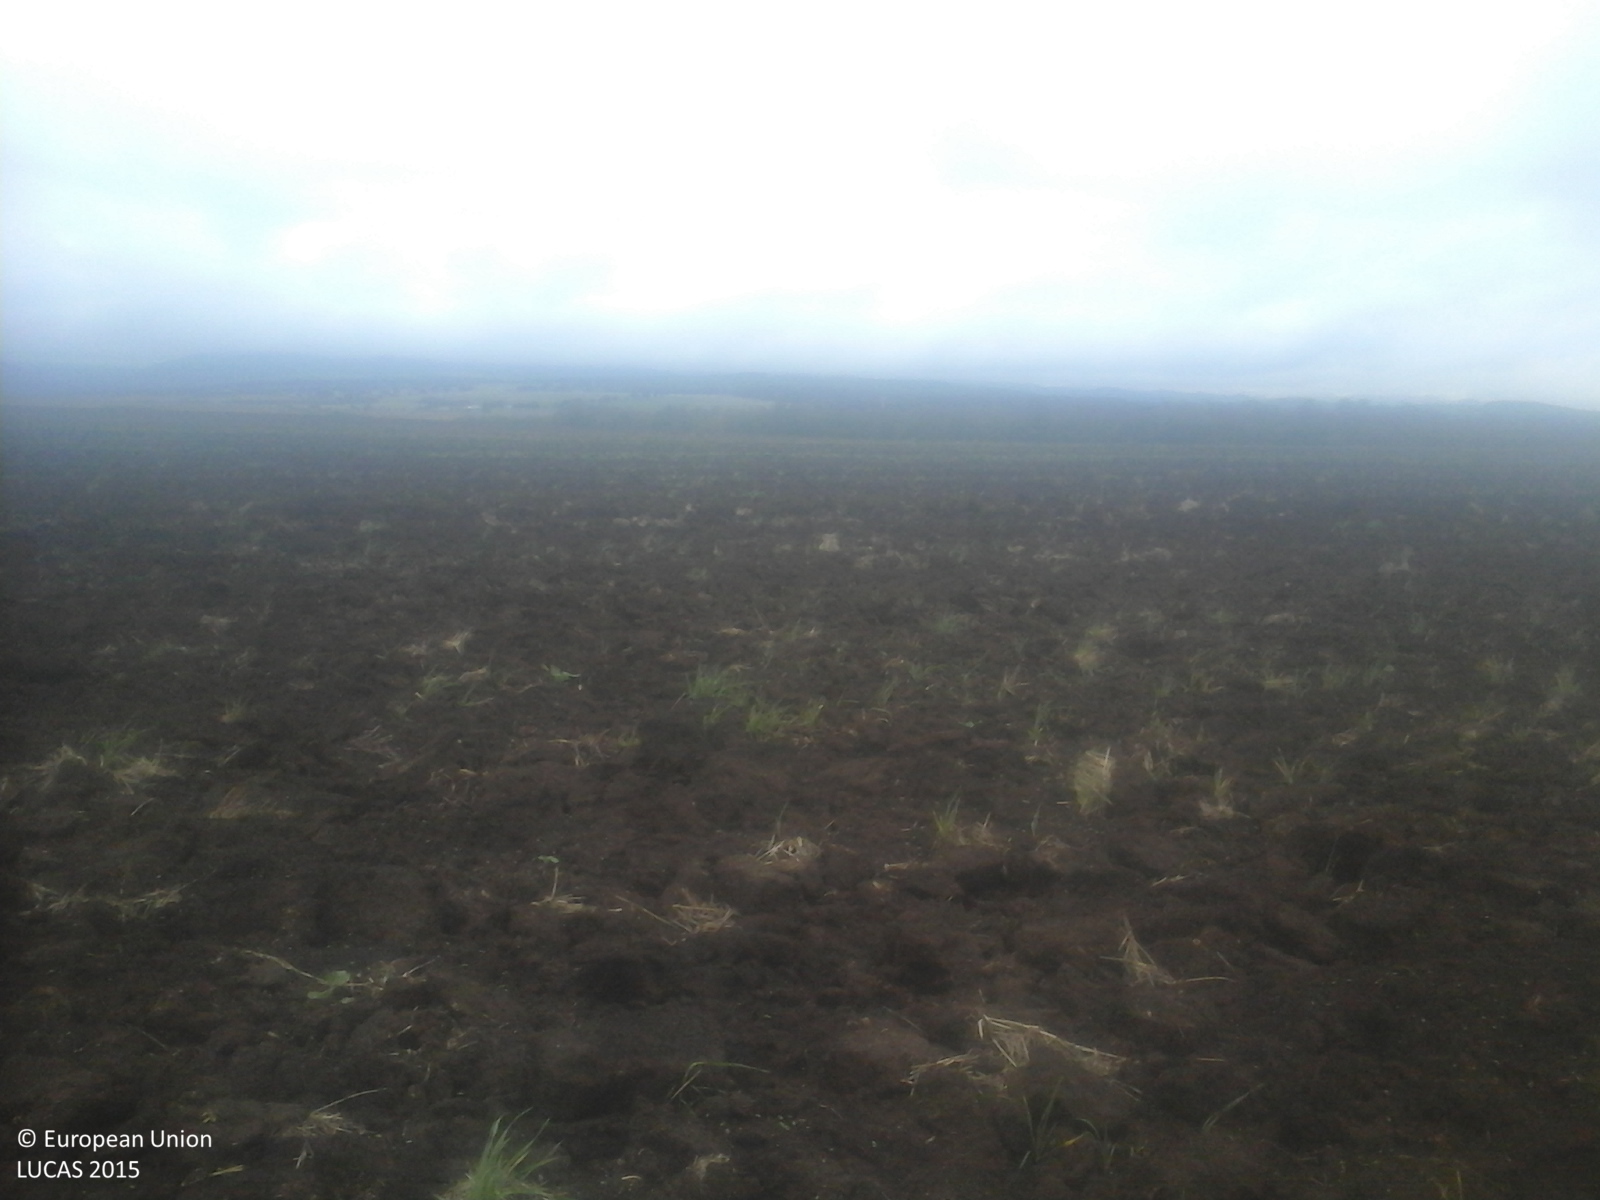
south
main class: Cropland
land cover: Common wheat
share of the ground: < 10 %
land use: Agriculture (excluding fallow land and kitchen gardens)
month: September
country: RO
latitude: 45.9543
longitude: 23.4424
